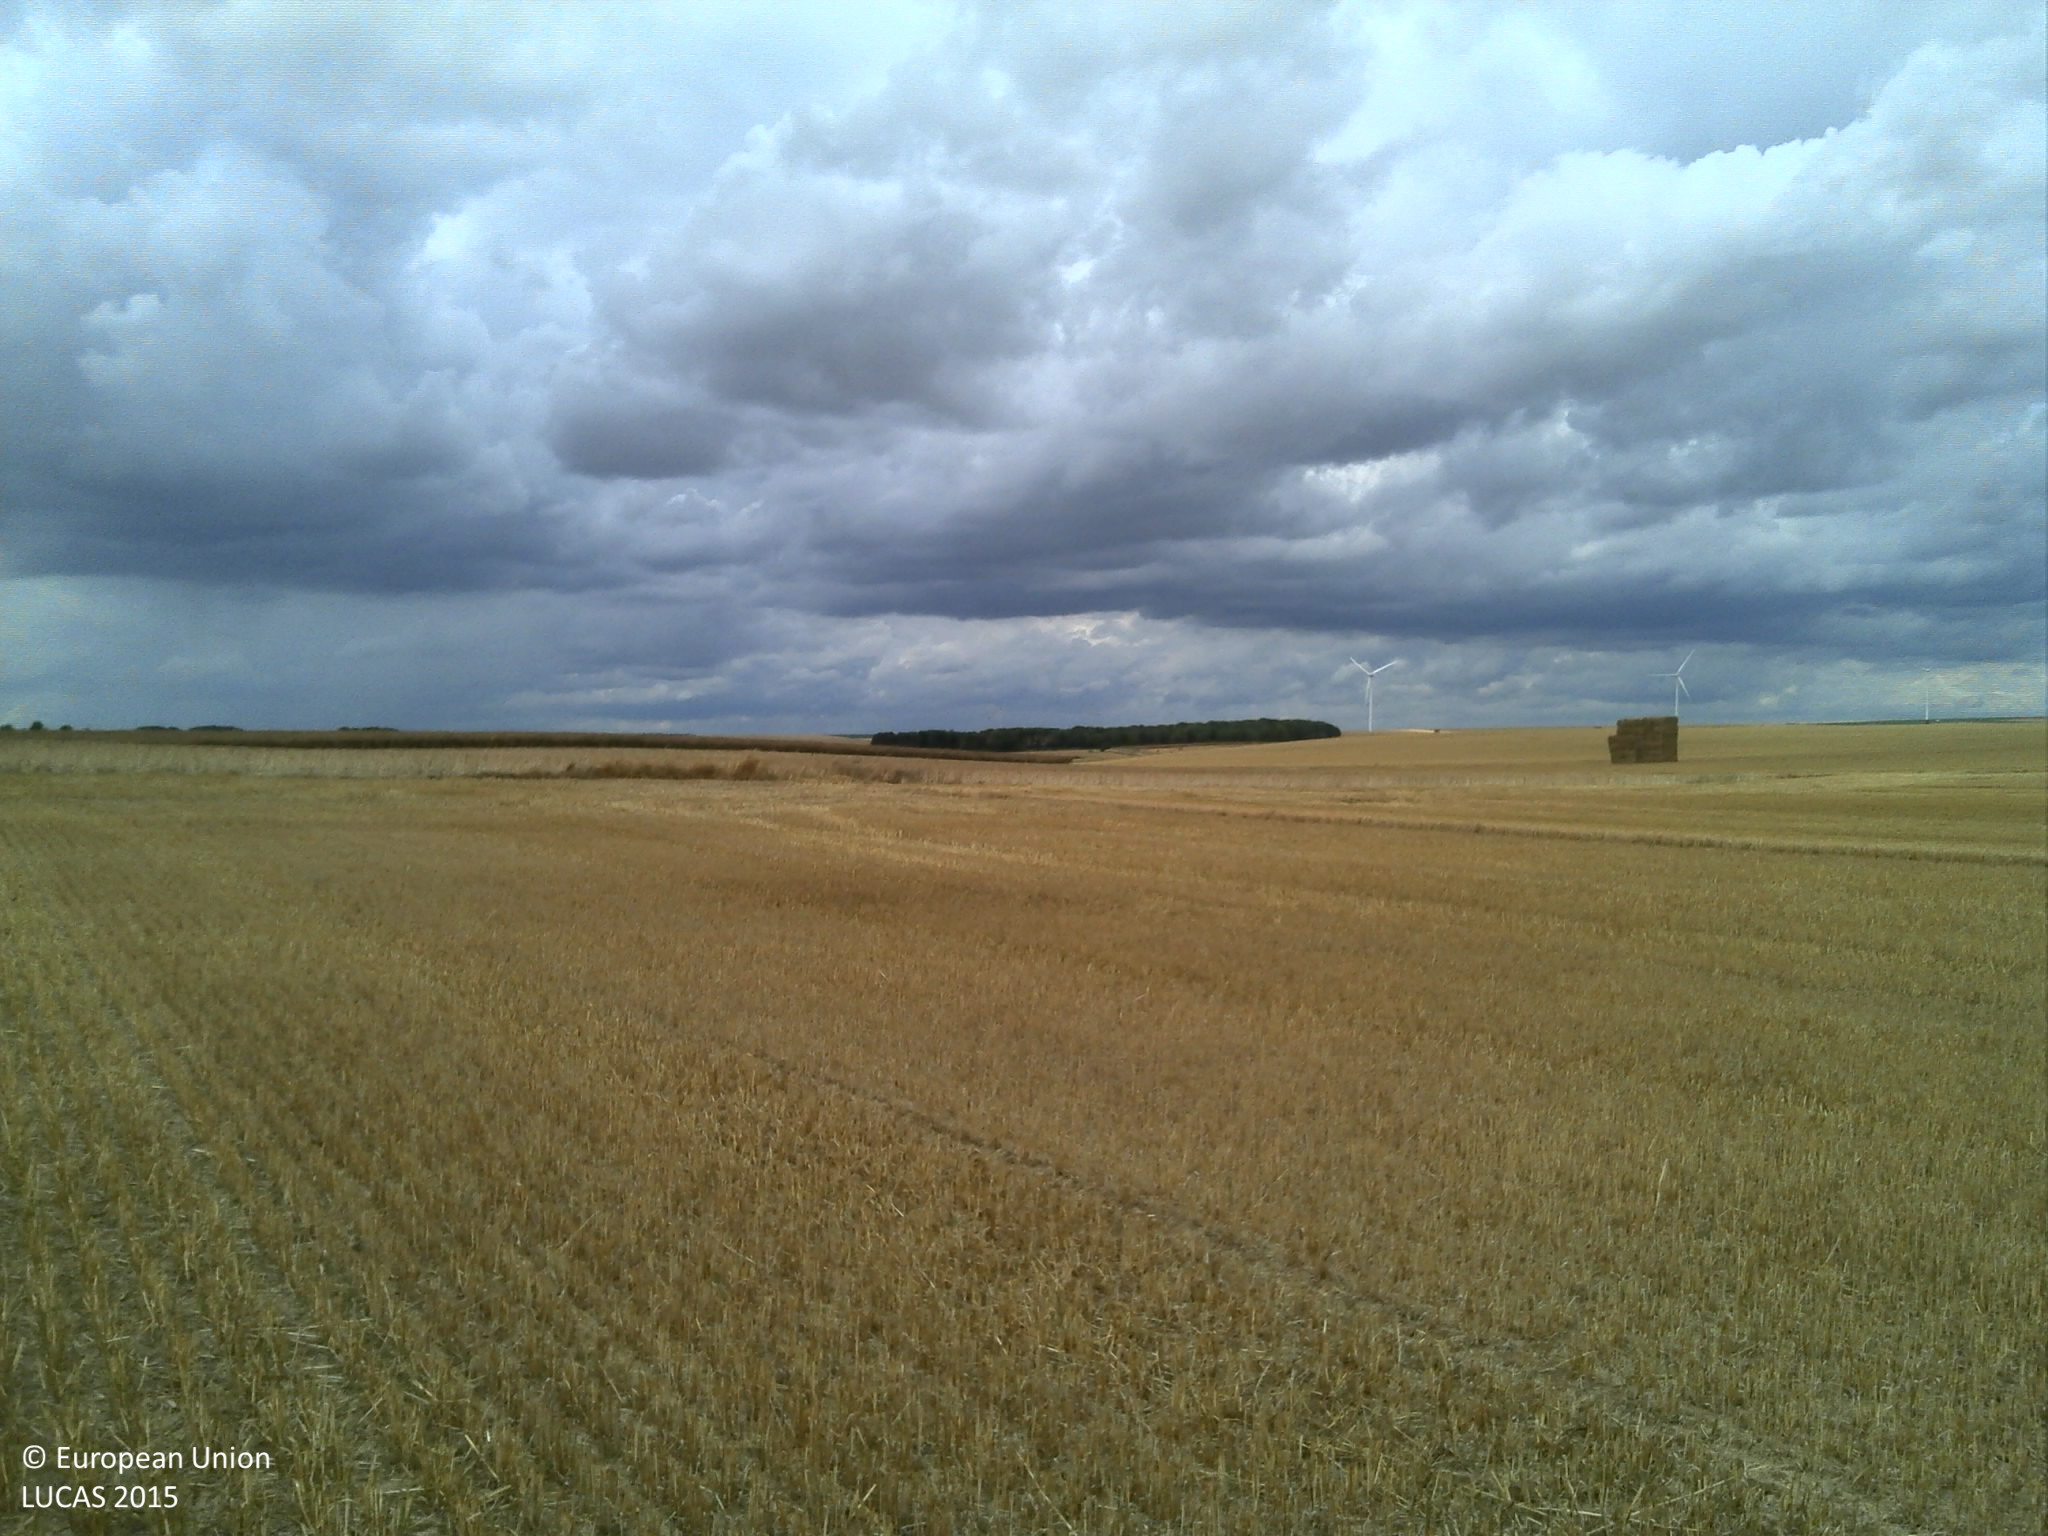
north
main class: Cropland
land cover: Barley
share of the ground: 50 - 75 %
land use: Agriculture (excluding fallow land and kitchen gardens)
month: July
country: FR
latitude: 49.3501
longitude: 4.5314
